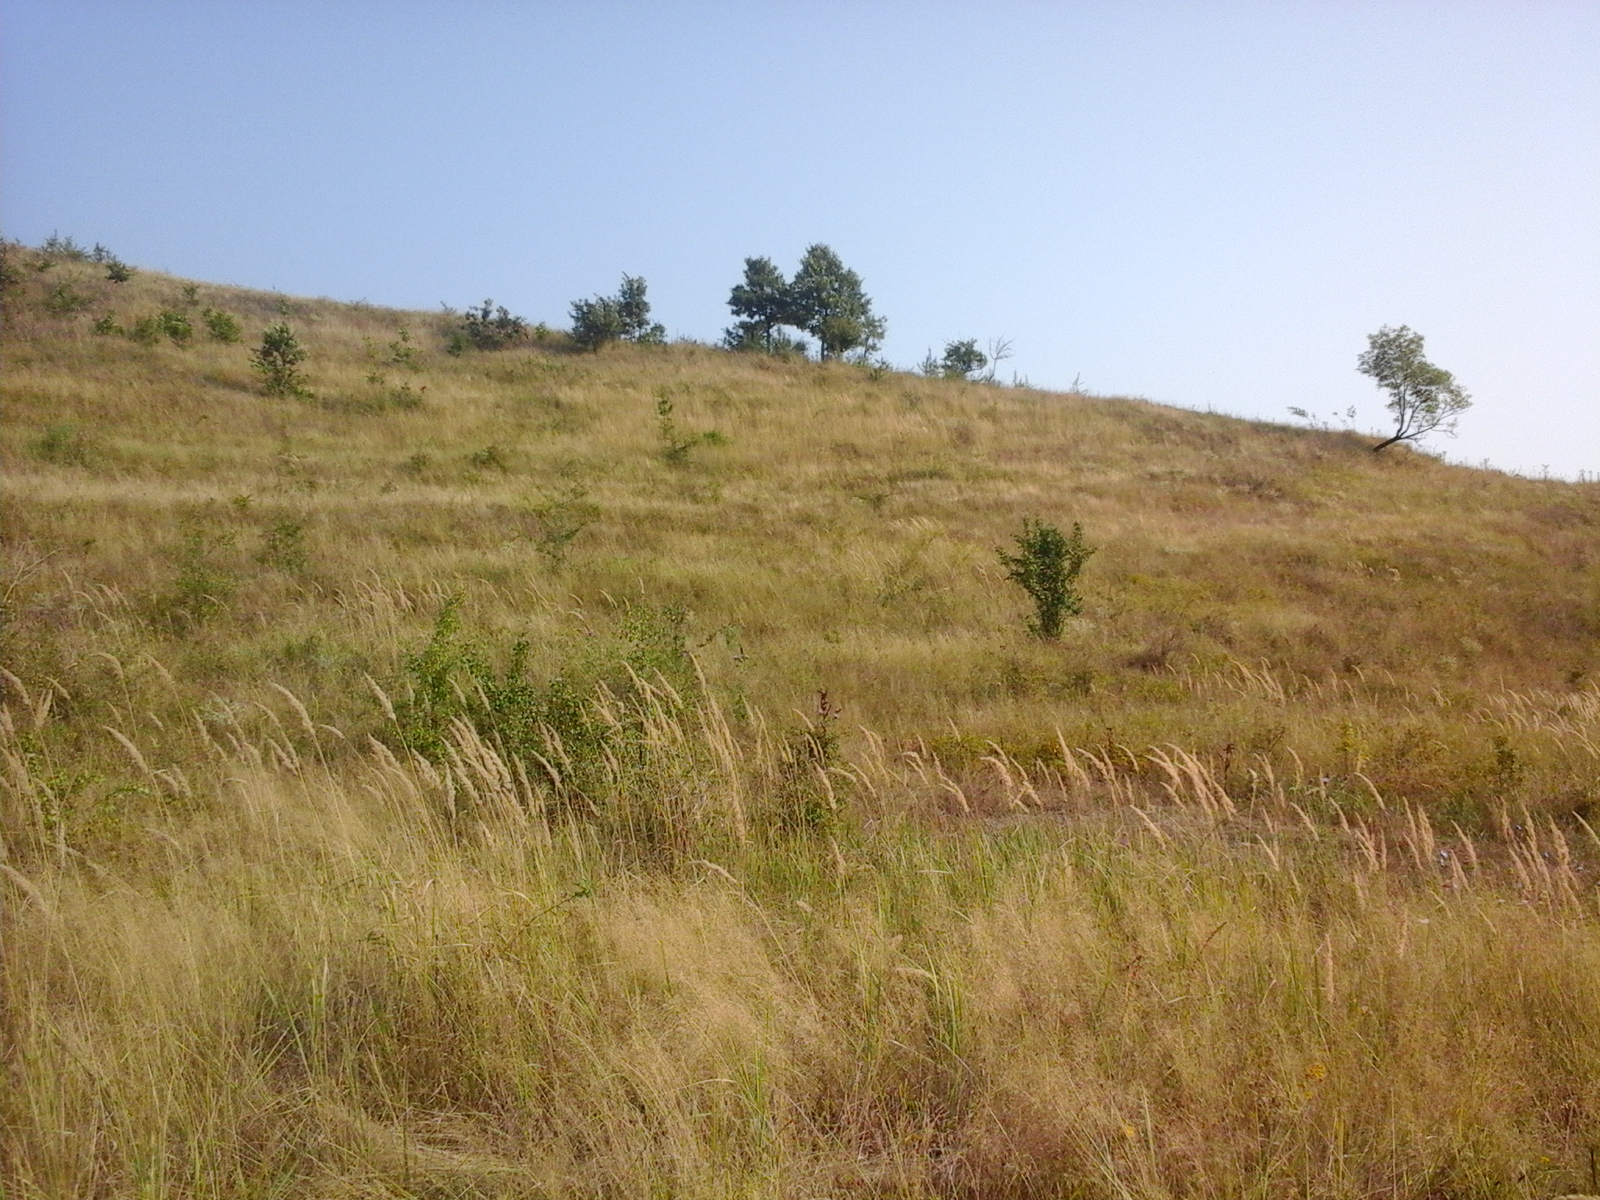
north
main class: Grassland
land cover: Grassland with sparse tree/shrub cover
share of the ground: > 75 %
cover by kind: herbaceous plants 90 %, broadleaved forest trees 5 %, shrubs 5 %
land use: Fallow land
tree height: < 5 m
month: August
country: RO
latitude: 44.5363
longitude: 23.8141
